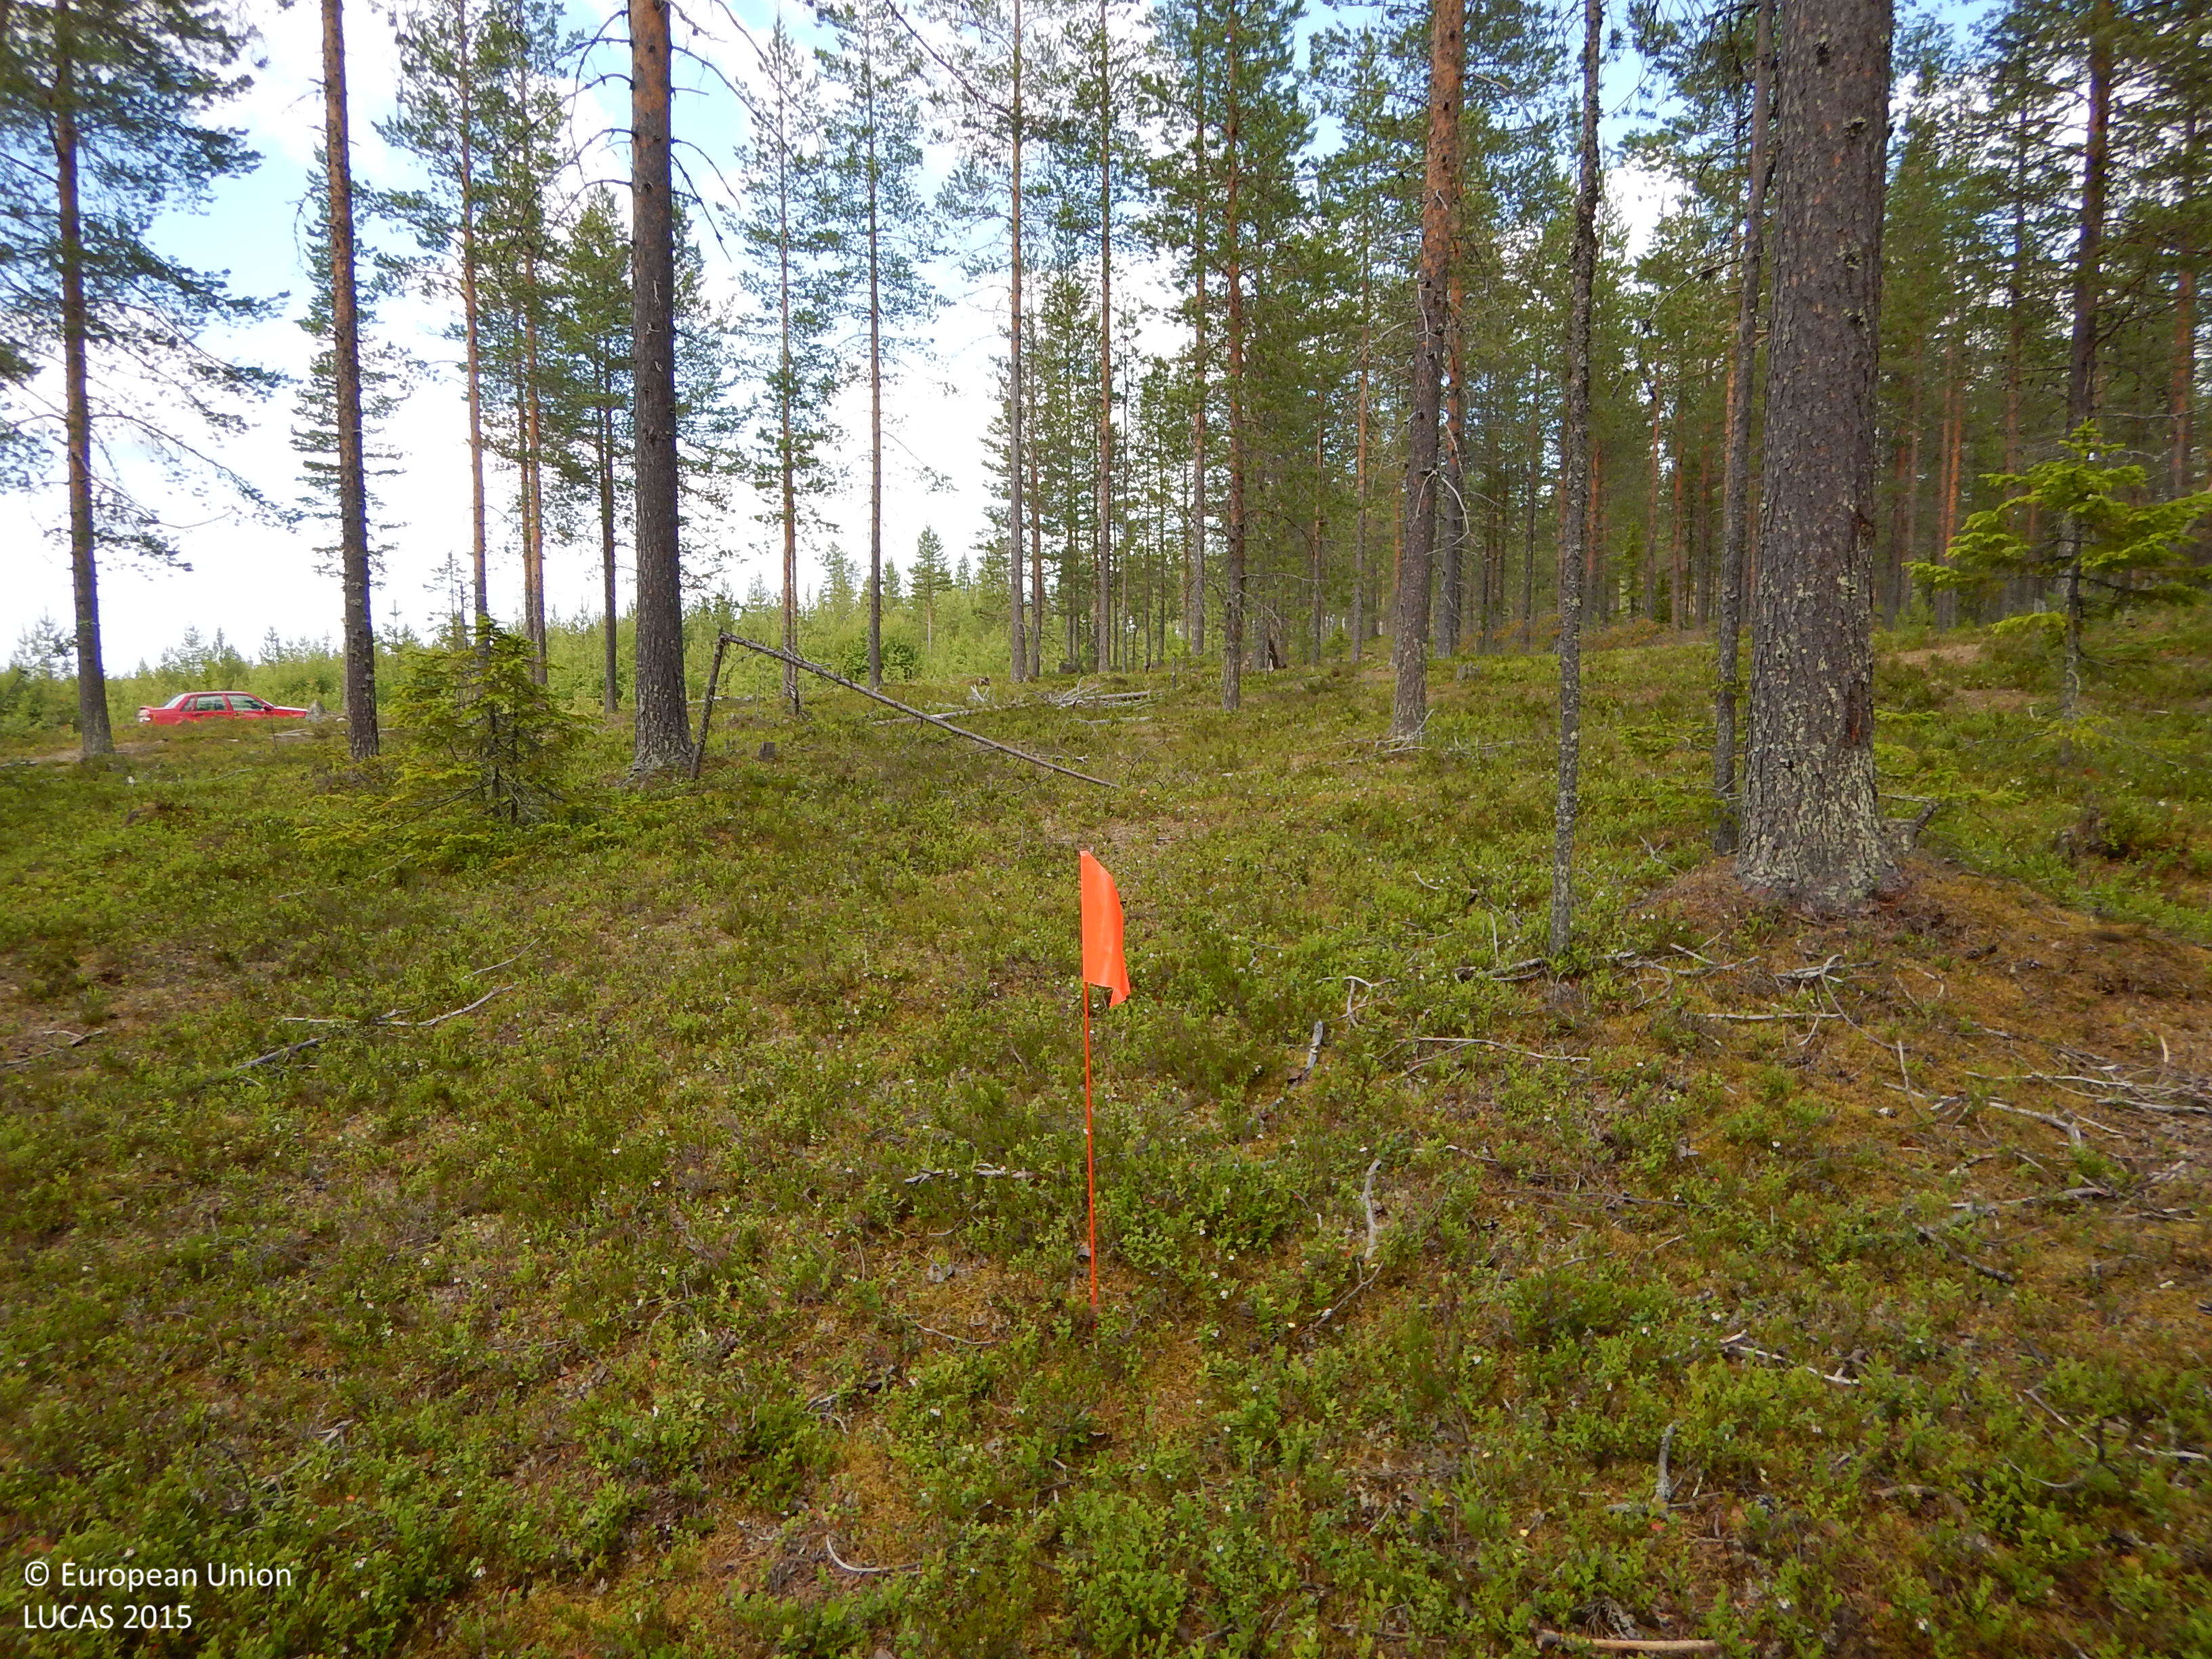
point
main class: Woodland
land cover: Pine dominated coniferous woodland
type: boreal forest
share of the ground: 50 - 75 %
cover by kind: coniferous forest trees 50 %, lichens and mosses 20 %, shrubs 15 %, herbaceous plants 15 %
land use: Forestry
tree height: > 5 m
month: July
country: SE
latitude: 65.0346
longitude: 19.9275
